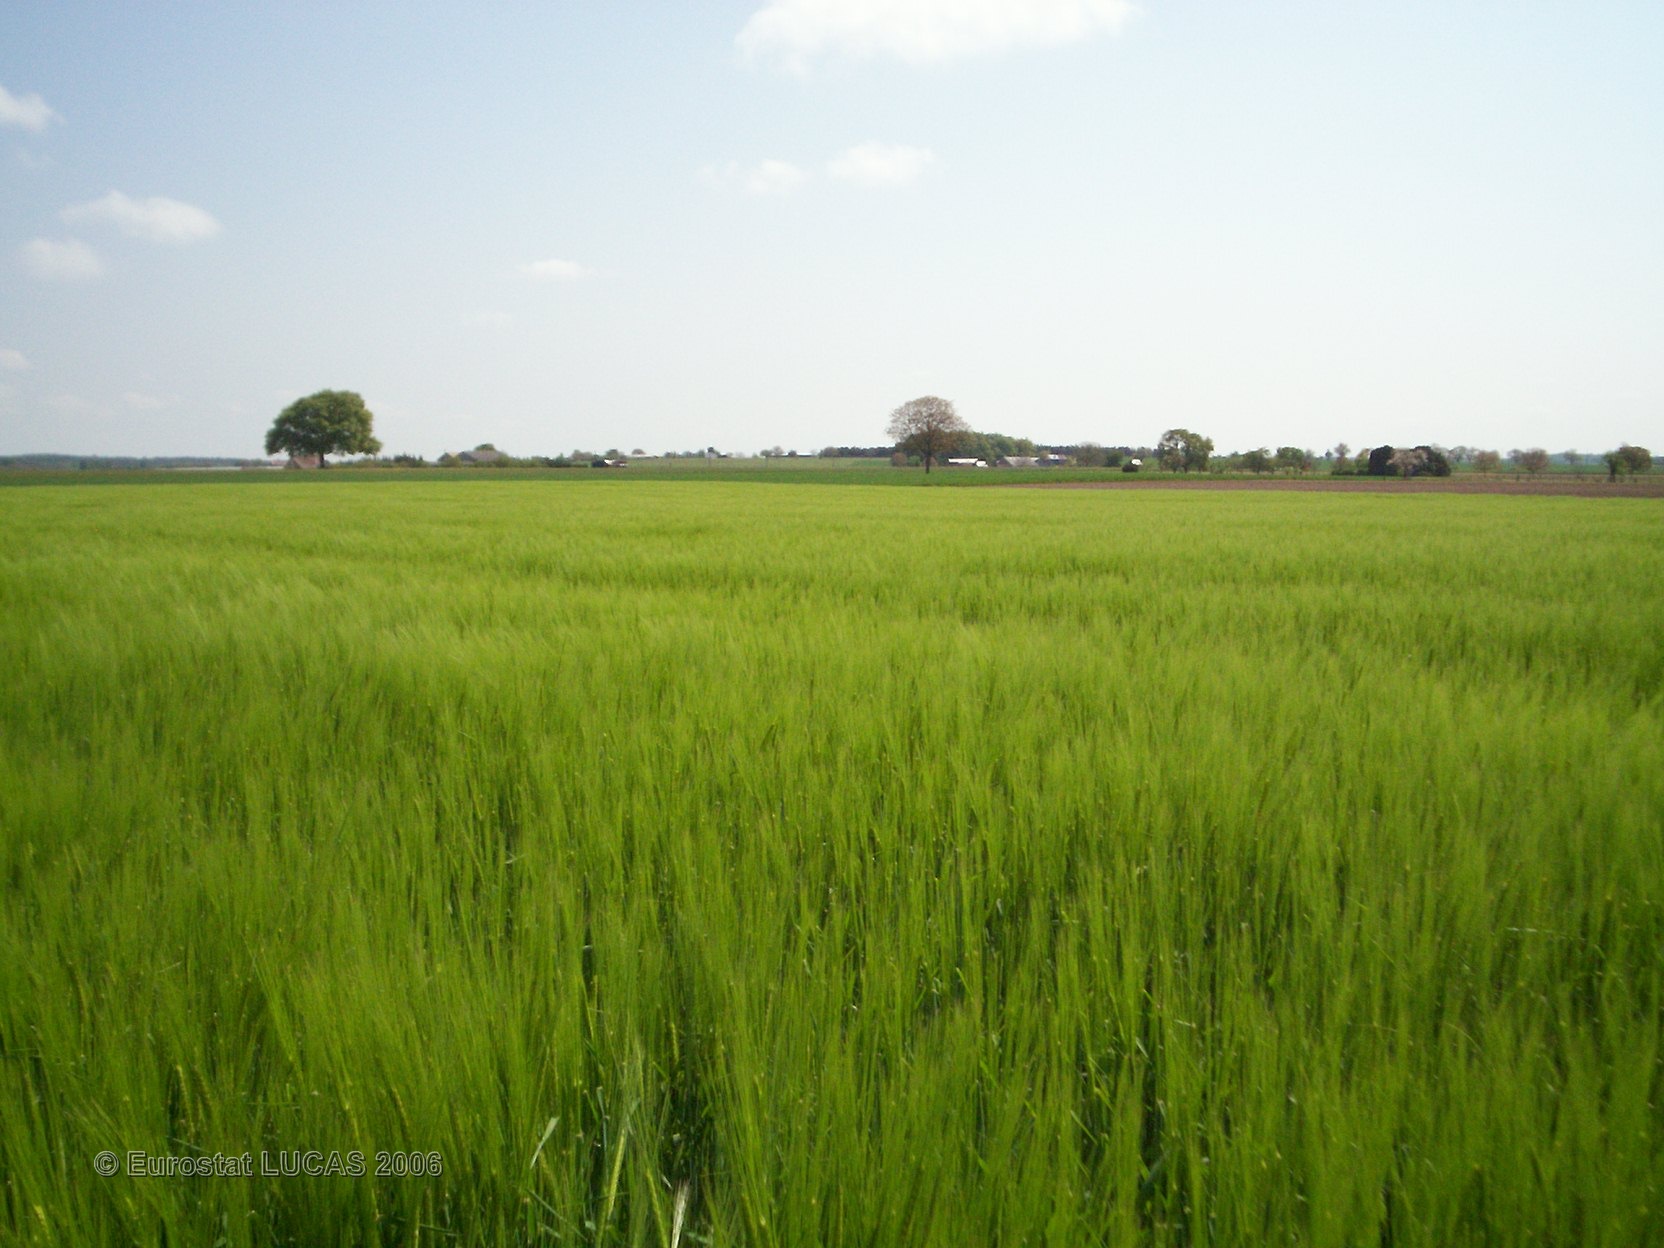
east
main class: Cropland
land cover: Barley
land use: Agriculture (excluding fallow land and kitchen gardens)
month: May
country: FR
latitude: 47.4014
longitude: 0.1573
